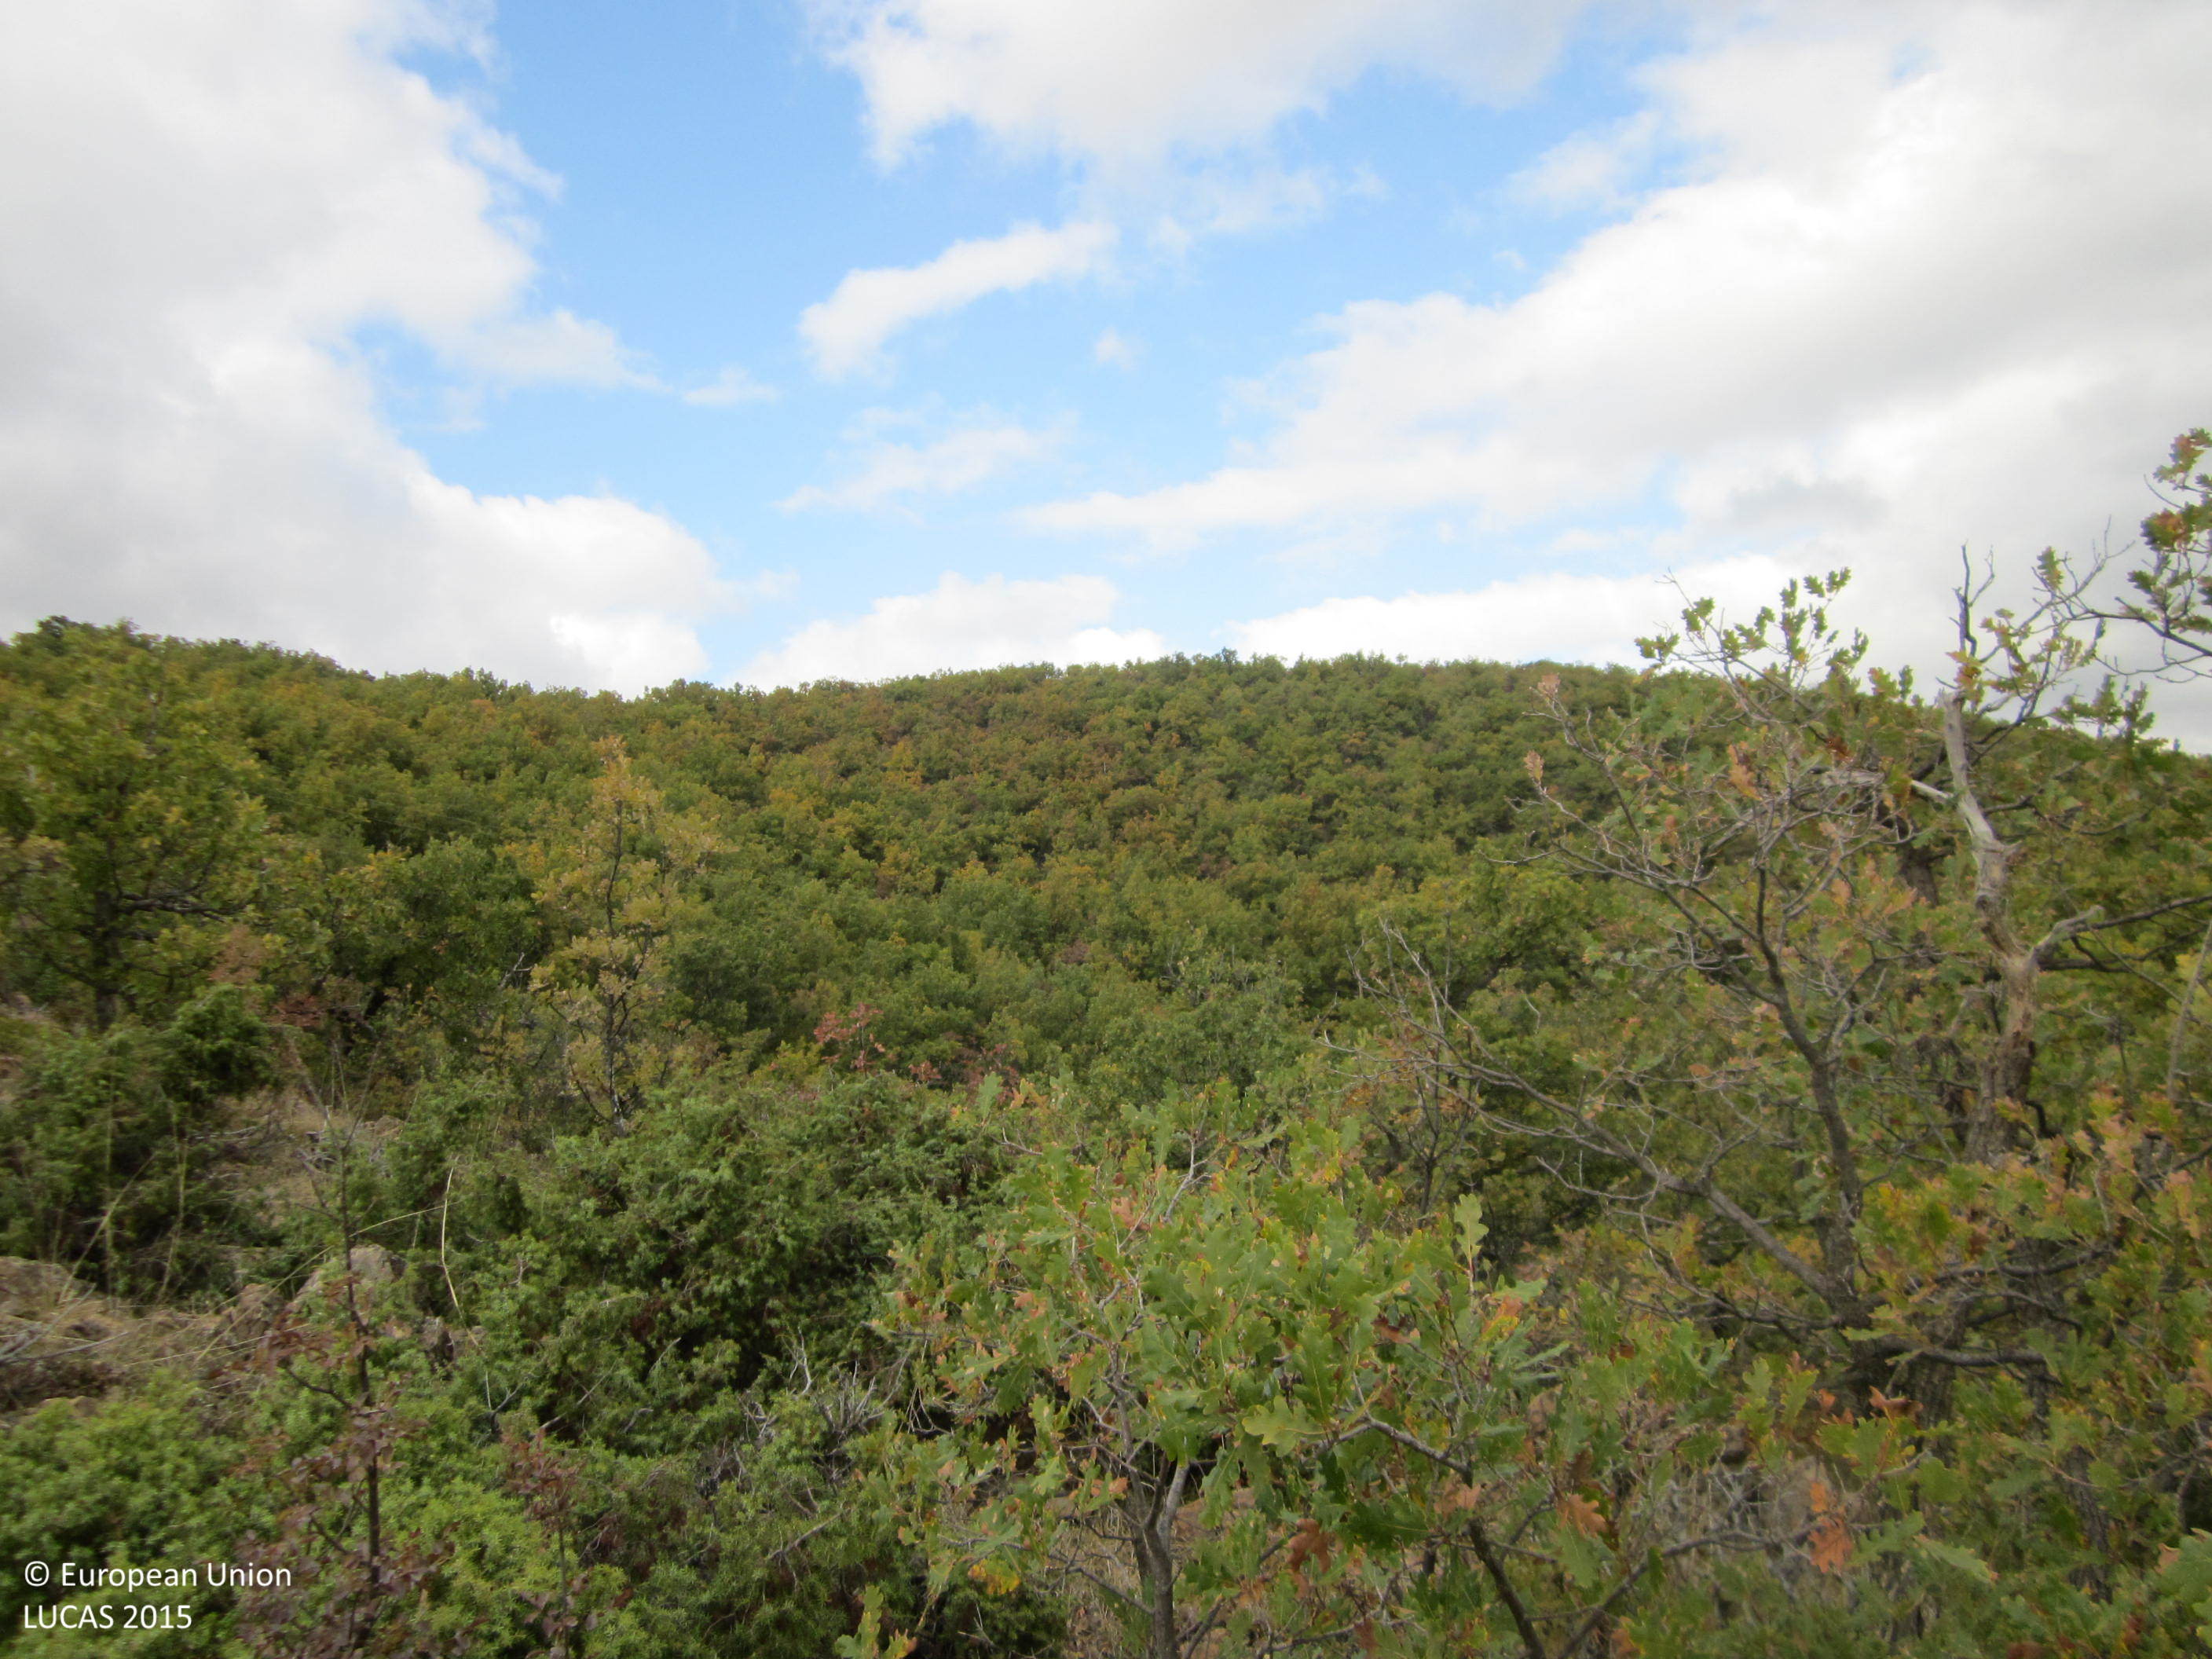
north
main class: Woodland
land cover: Broadleaved woodland
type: mesophytic deciduous forest
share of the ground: > 75 %
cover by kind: broadleaved forest trees 100 %
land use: Forestry
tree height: > 5 m
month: November
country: BG
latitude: 41.4085
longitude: 25.8908
